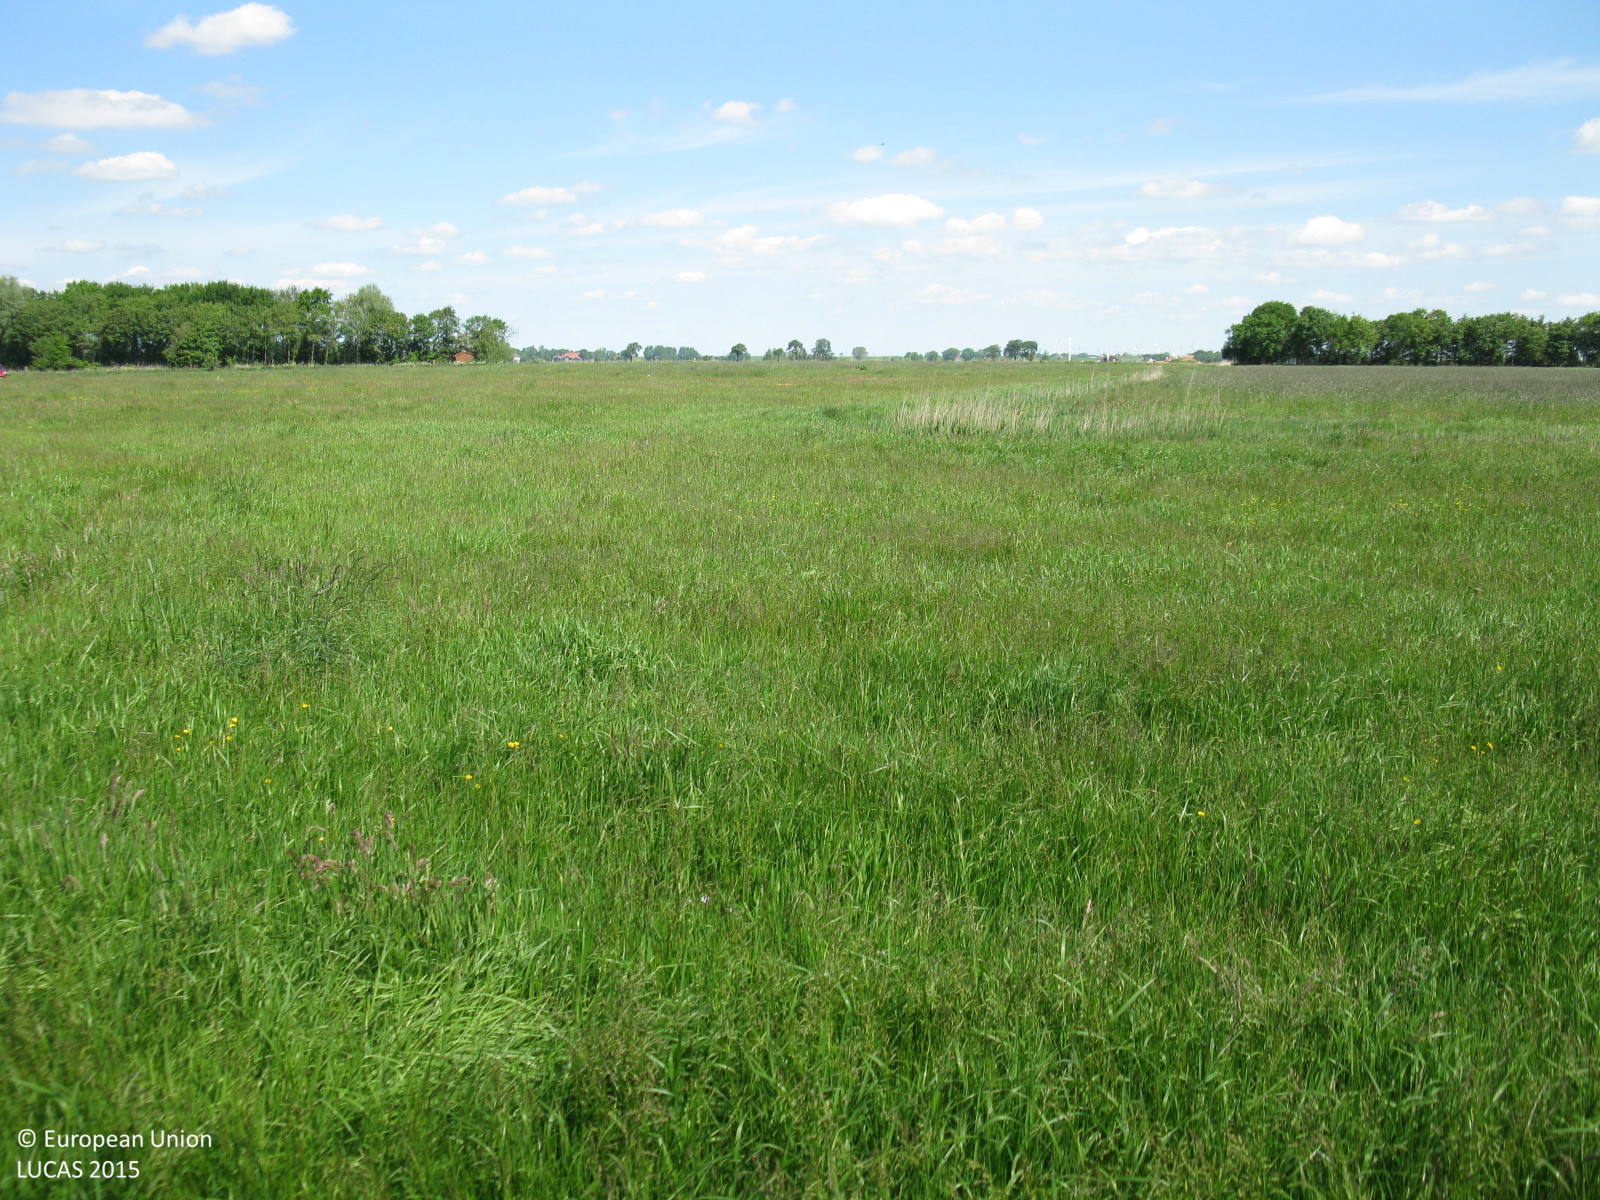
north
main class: Grassland
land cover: Grassland without tree/shrub cover
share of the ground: > 75 %
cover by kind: herbaceous plants 100 %
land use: Agriculture (excluding fallow land and kitchen gardens)
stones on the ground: < 10 %
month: June
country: DE
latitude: 53.2823
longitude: 7.3158
